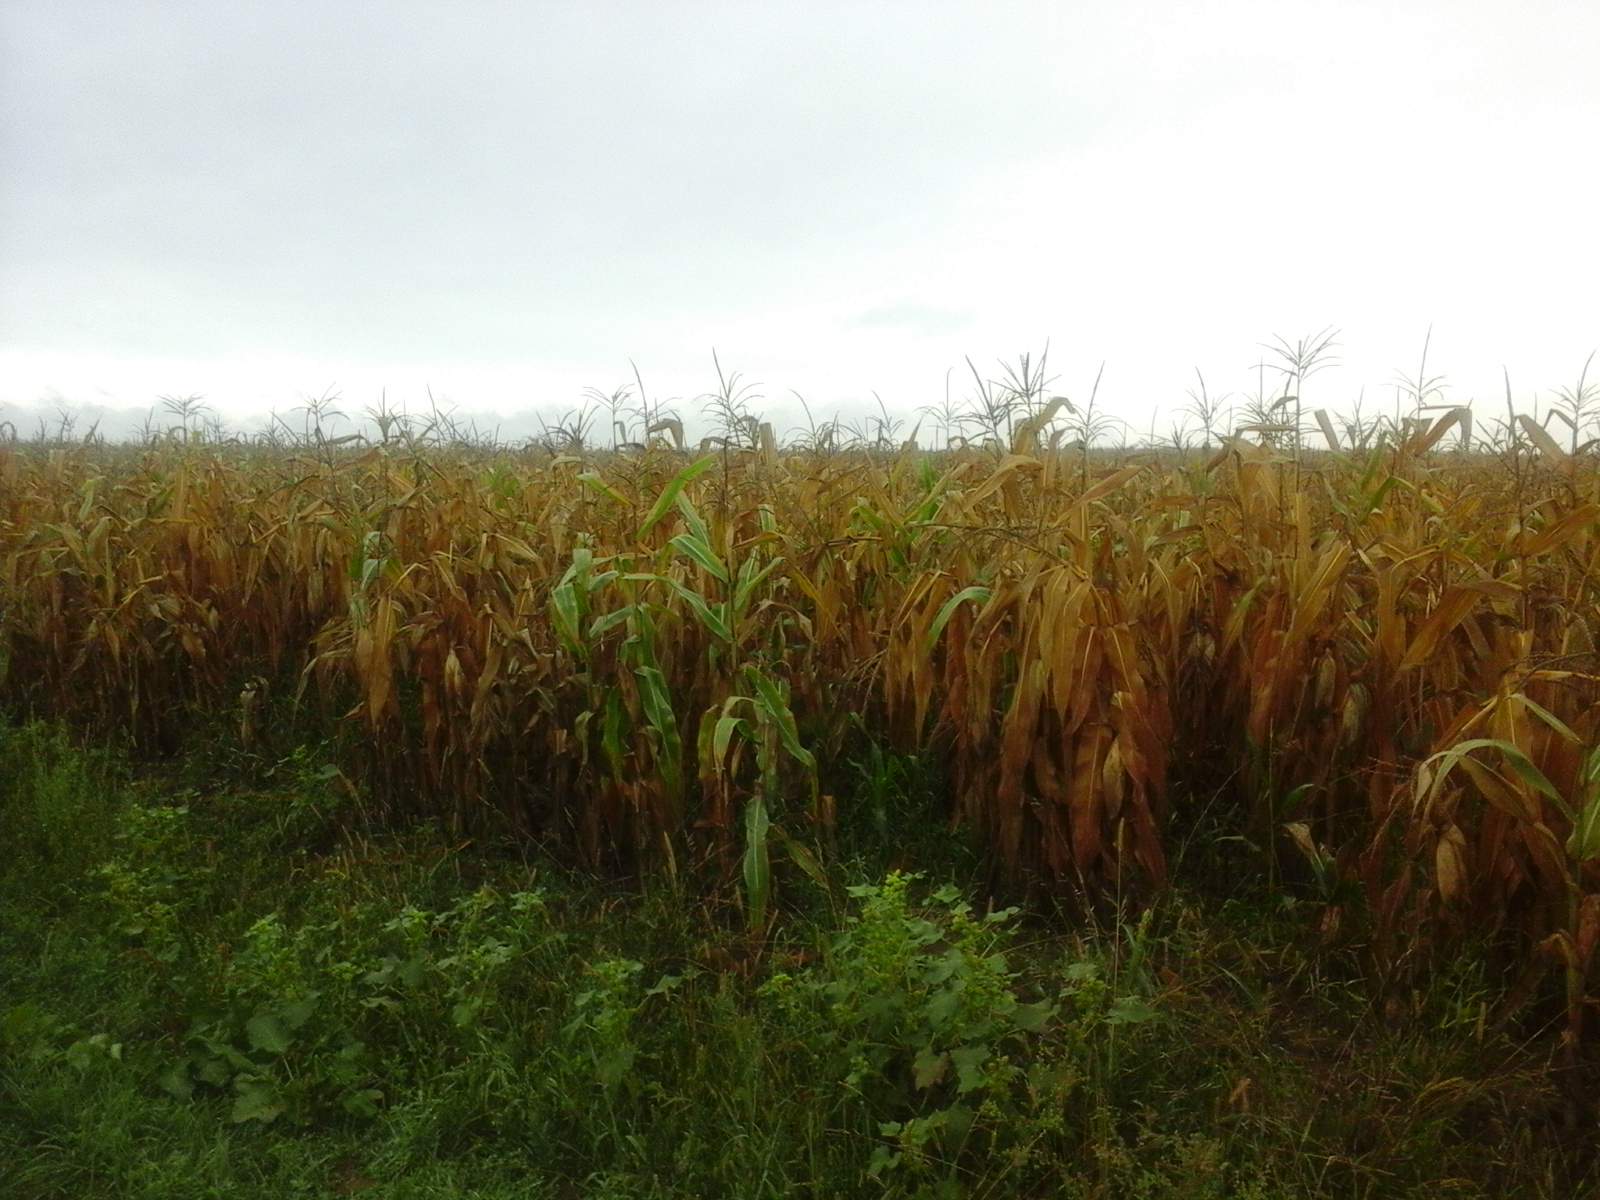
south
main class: Cropland
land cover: Lucerne
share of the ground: > 75 %
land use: Agriculture (excluding fallow land and kitchen gardens)
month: September
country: RO
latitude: 47.0299
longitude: 21.7415
